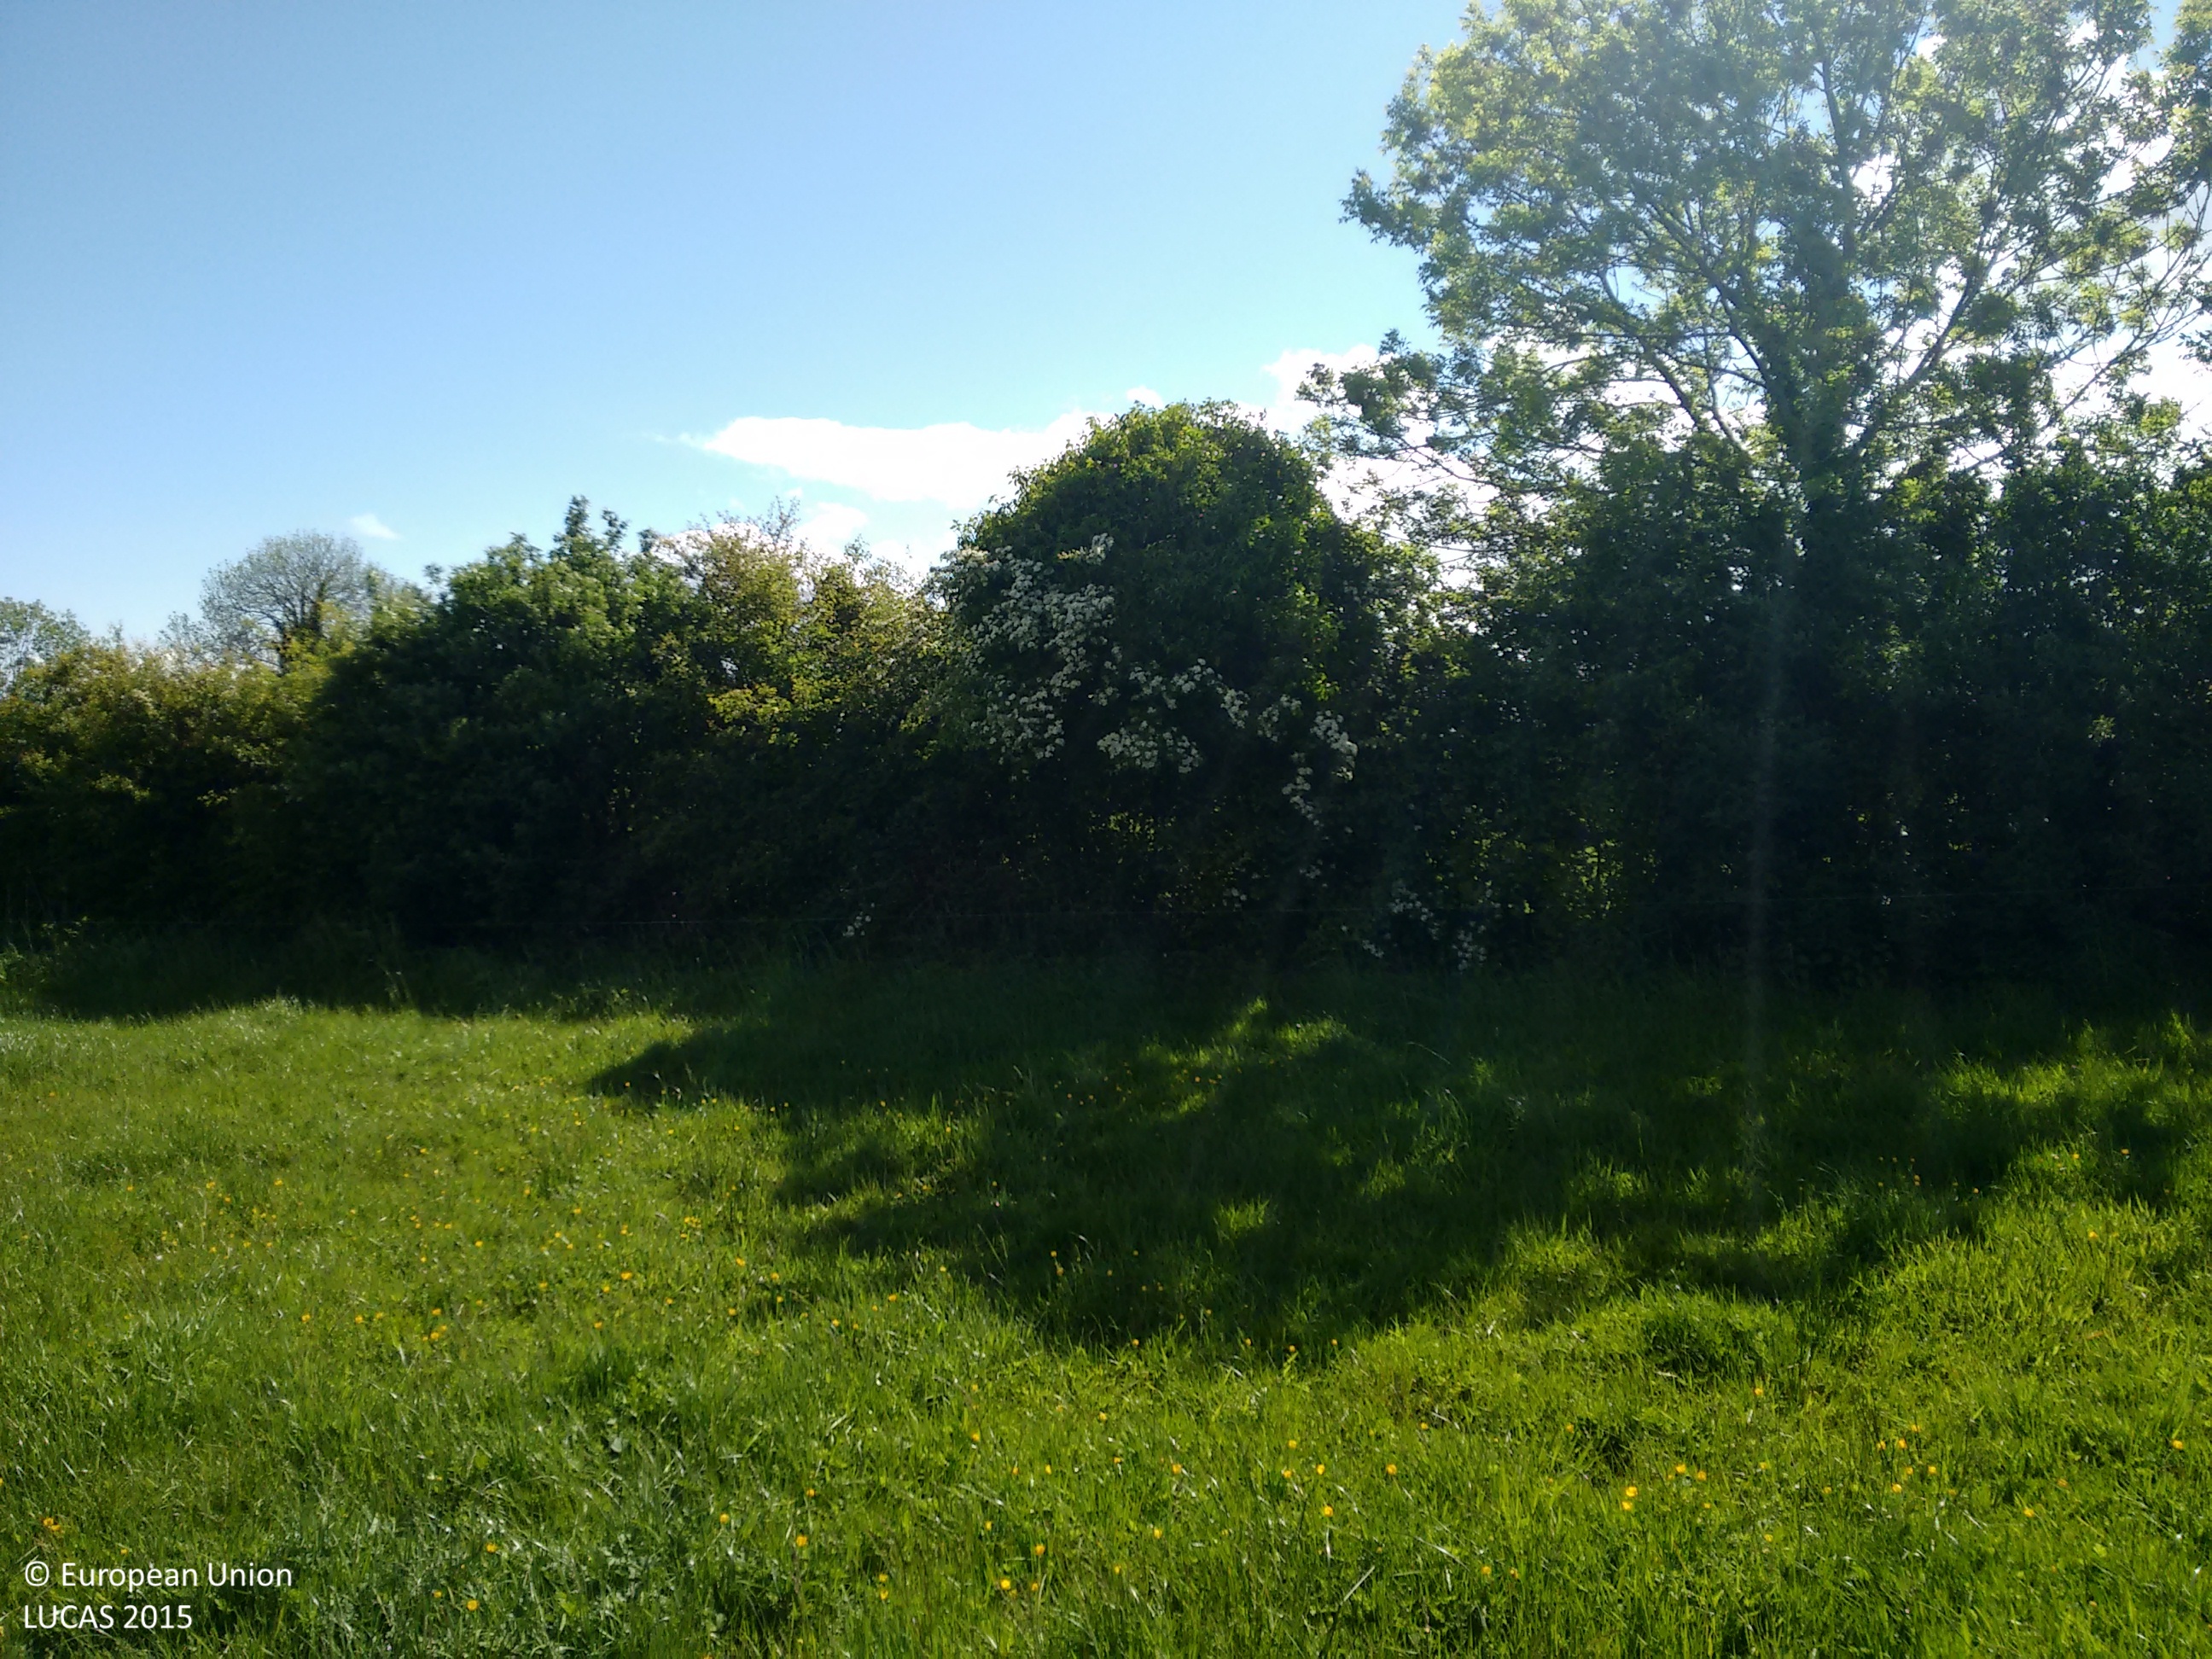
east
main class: Grassland
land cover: Grassland without tree/shrub cover
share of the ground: > 75 %
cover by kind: herbaceous plants 100 %
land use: Agriculture (excluding fallow land and kitchen gardens)
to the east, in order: Grassland without tree/shrub cover; Ditches and canals; Managed hedges; Grassland without tree/shrub cover; Ditches and canals; Managed hedges; Fences; Grassland without tree/shrub cover
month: June
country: IE
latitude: 53.3878
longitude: -6.9660
